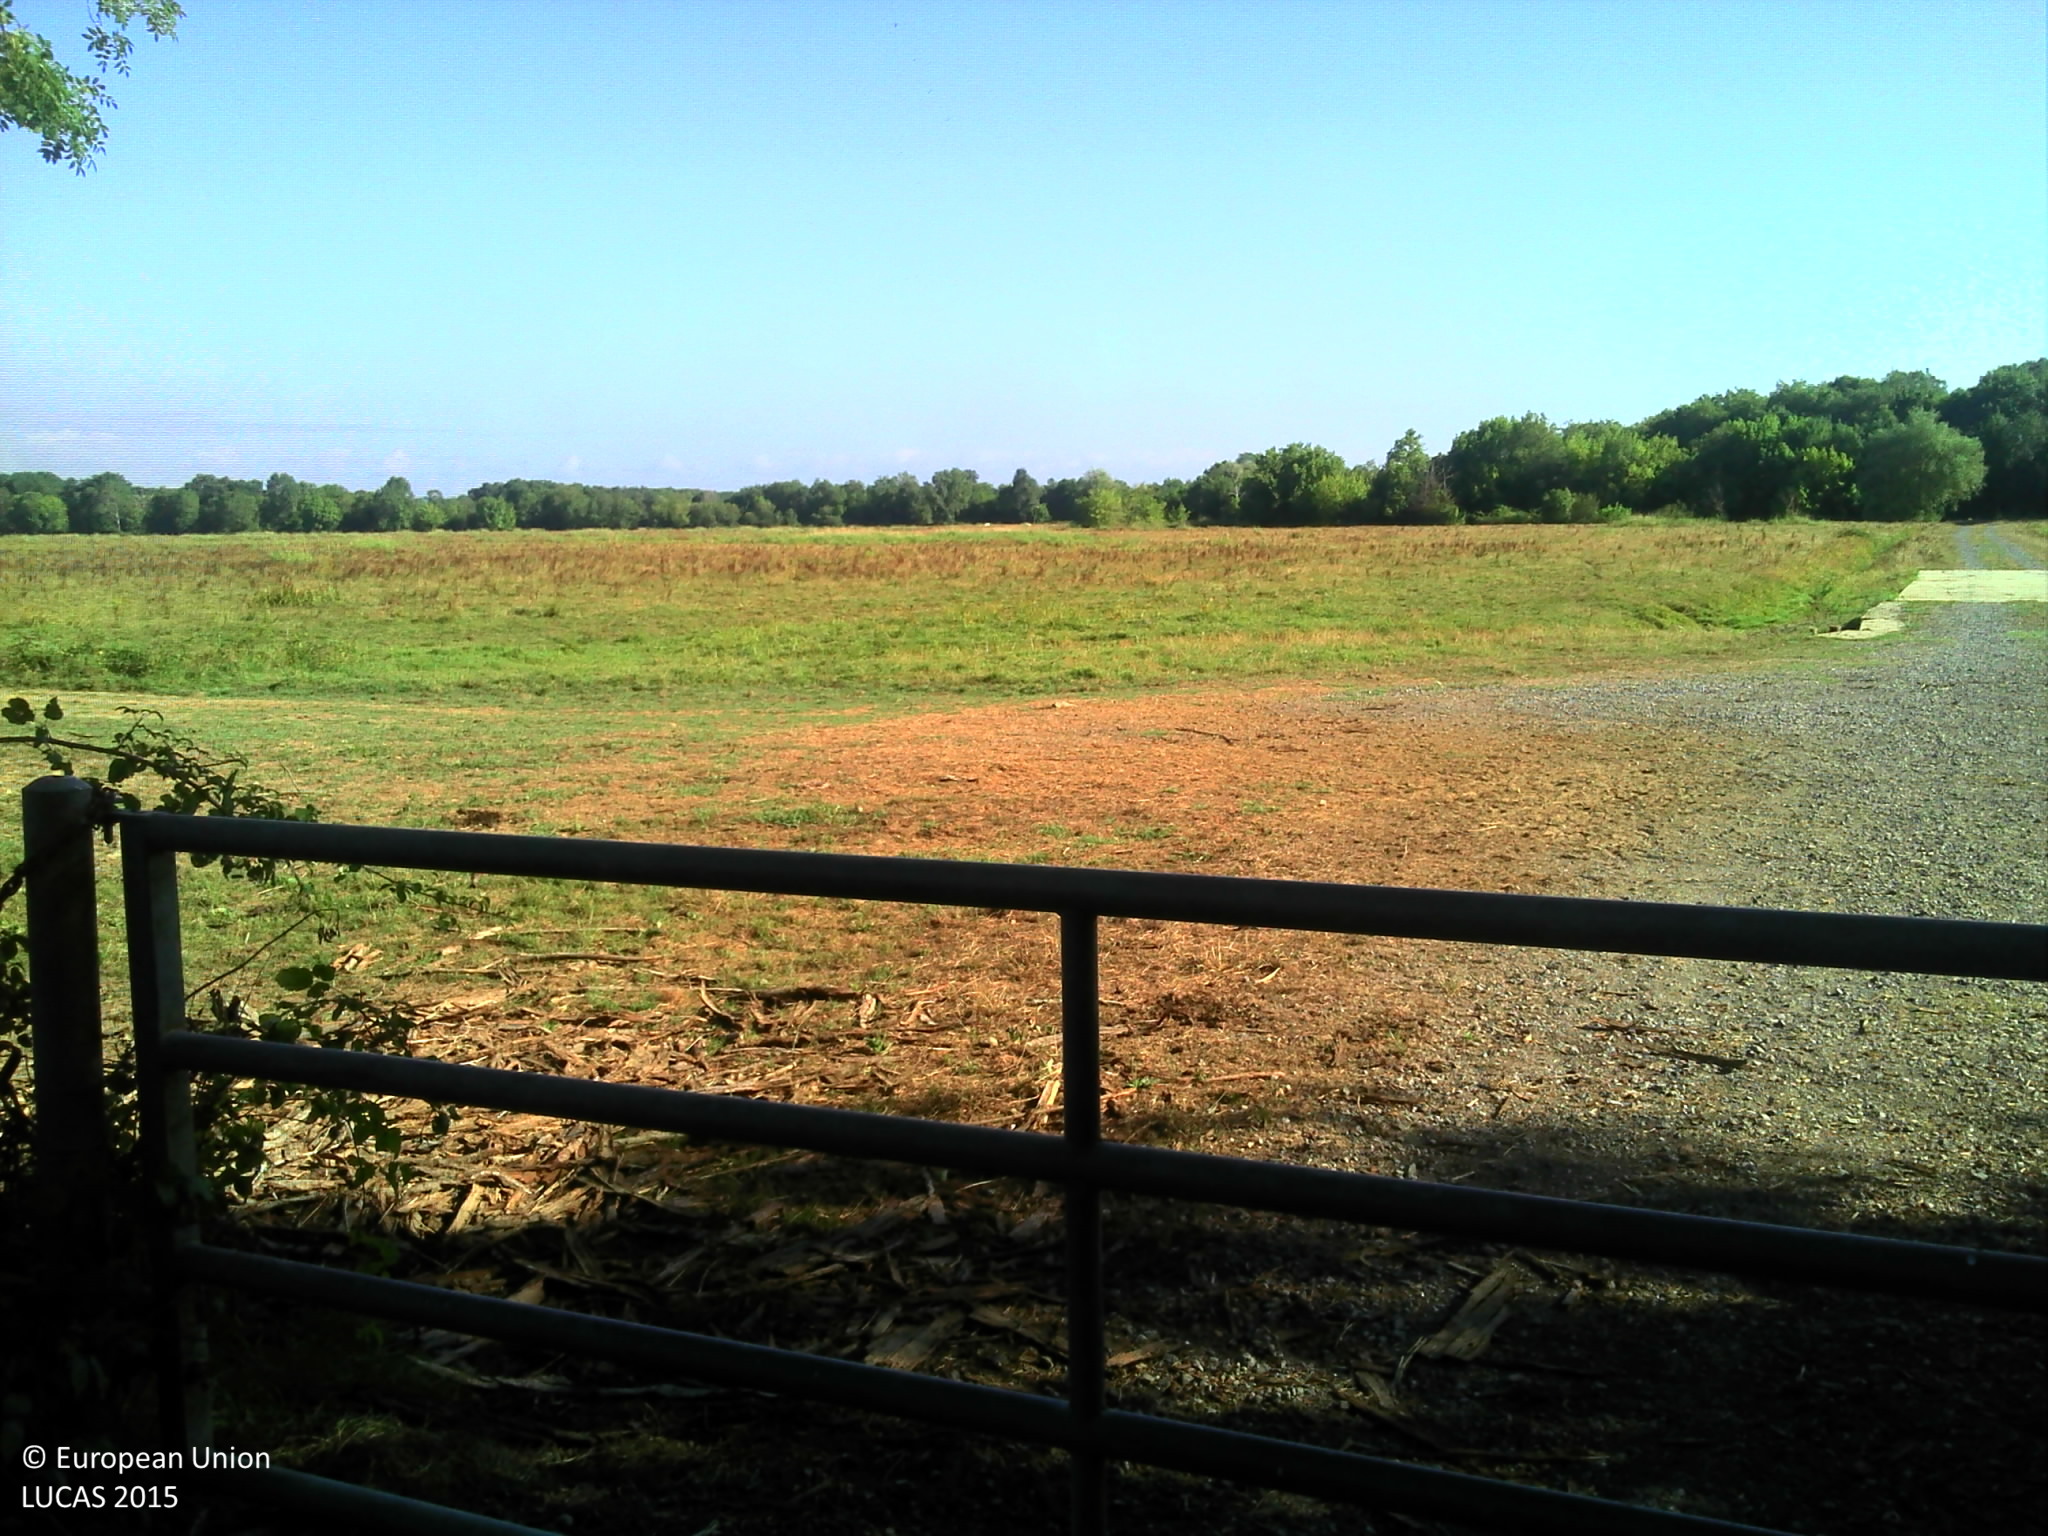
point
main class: Grassland
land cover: Grassland without tree/shrub cover
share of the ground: > 75 %
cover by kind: herbaceous plants 100 %
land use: Agriculture (excluding fallow land and kitchen gardens)
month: July
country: FR
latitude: 43.6580
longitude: -1.1388
